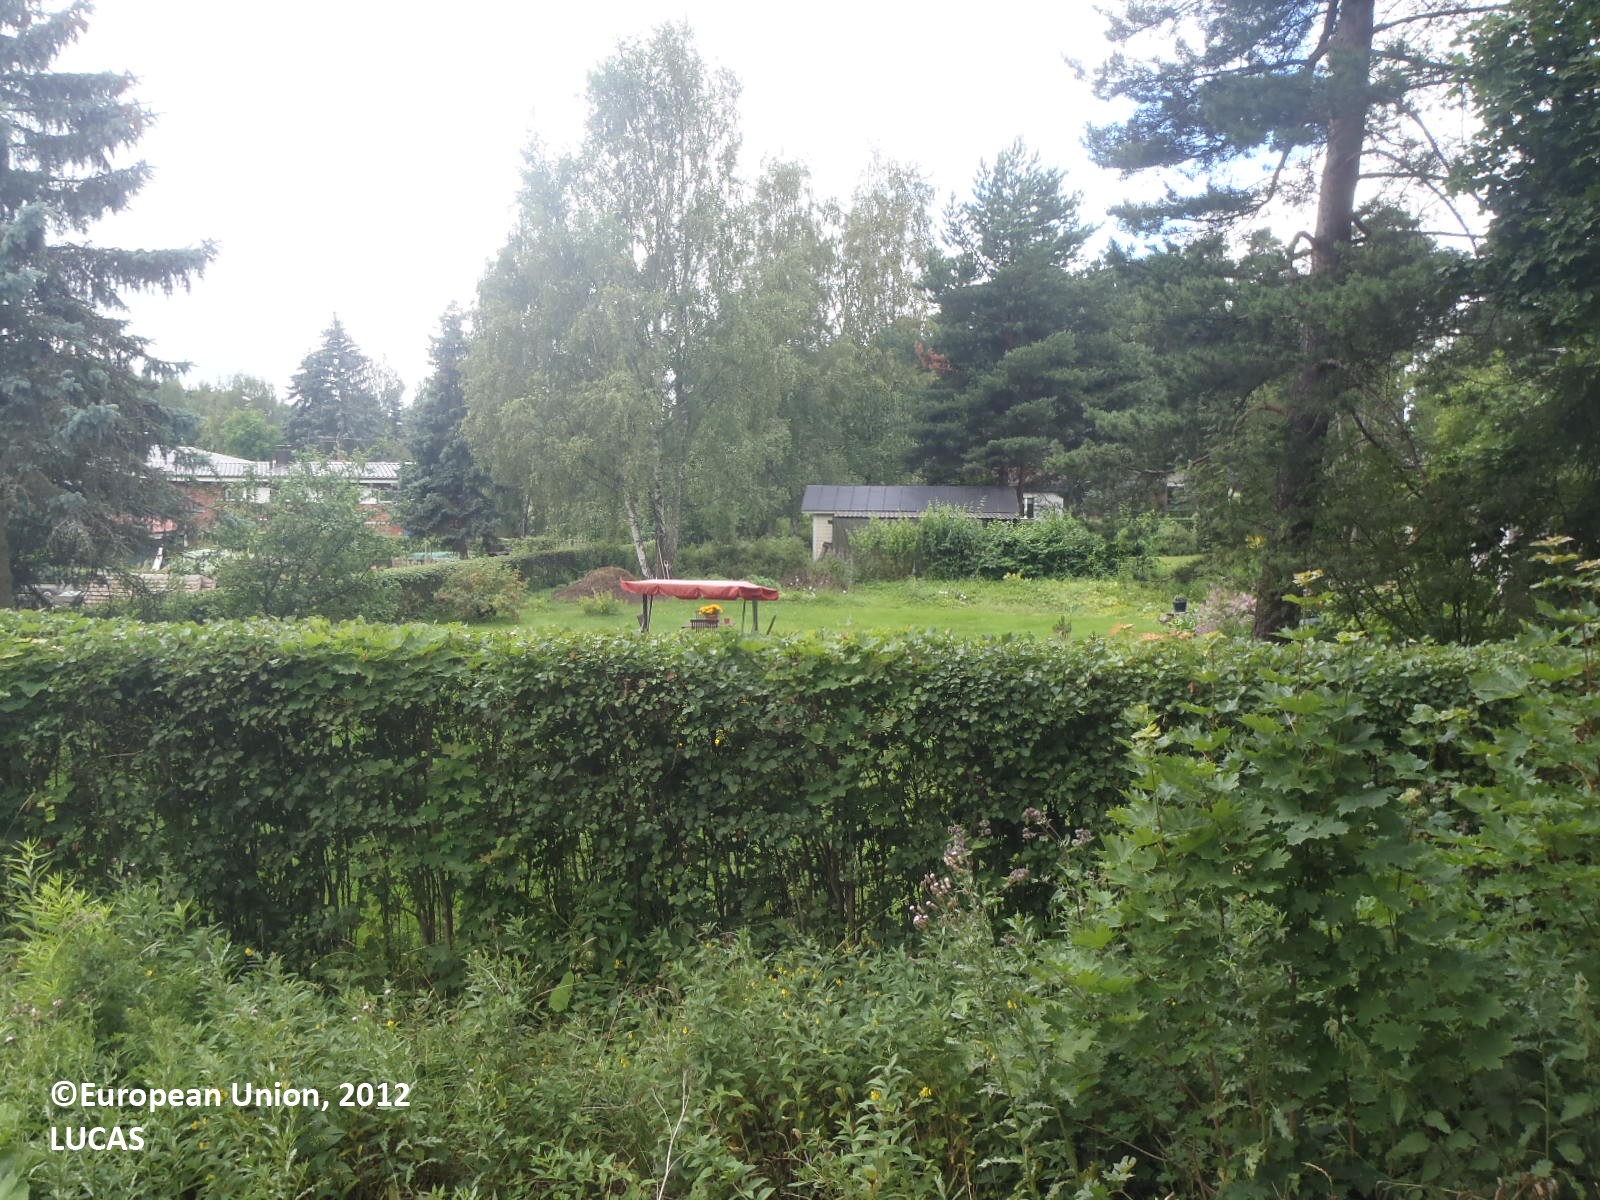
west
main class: Grassland
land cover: Grassland with sparse tree/shrub cover
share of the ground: > 75 %
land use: Residential
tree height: > 5 m
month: July
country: FI
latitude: 60.4671
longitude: 22.2337
